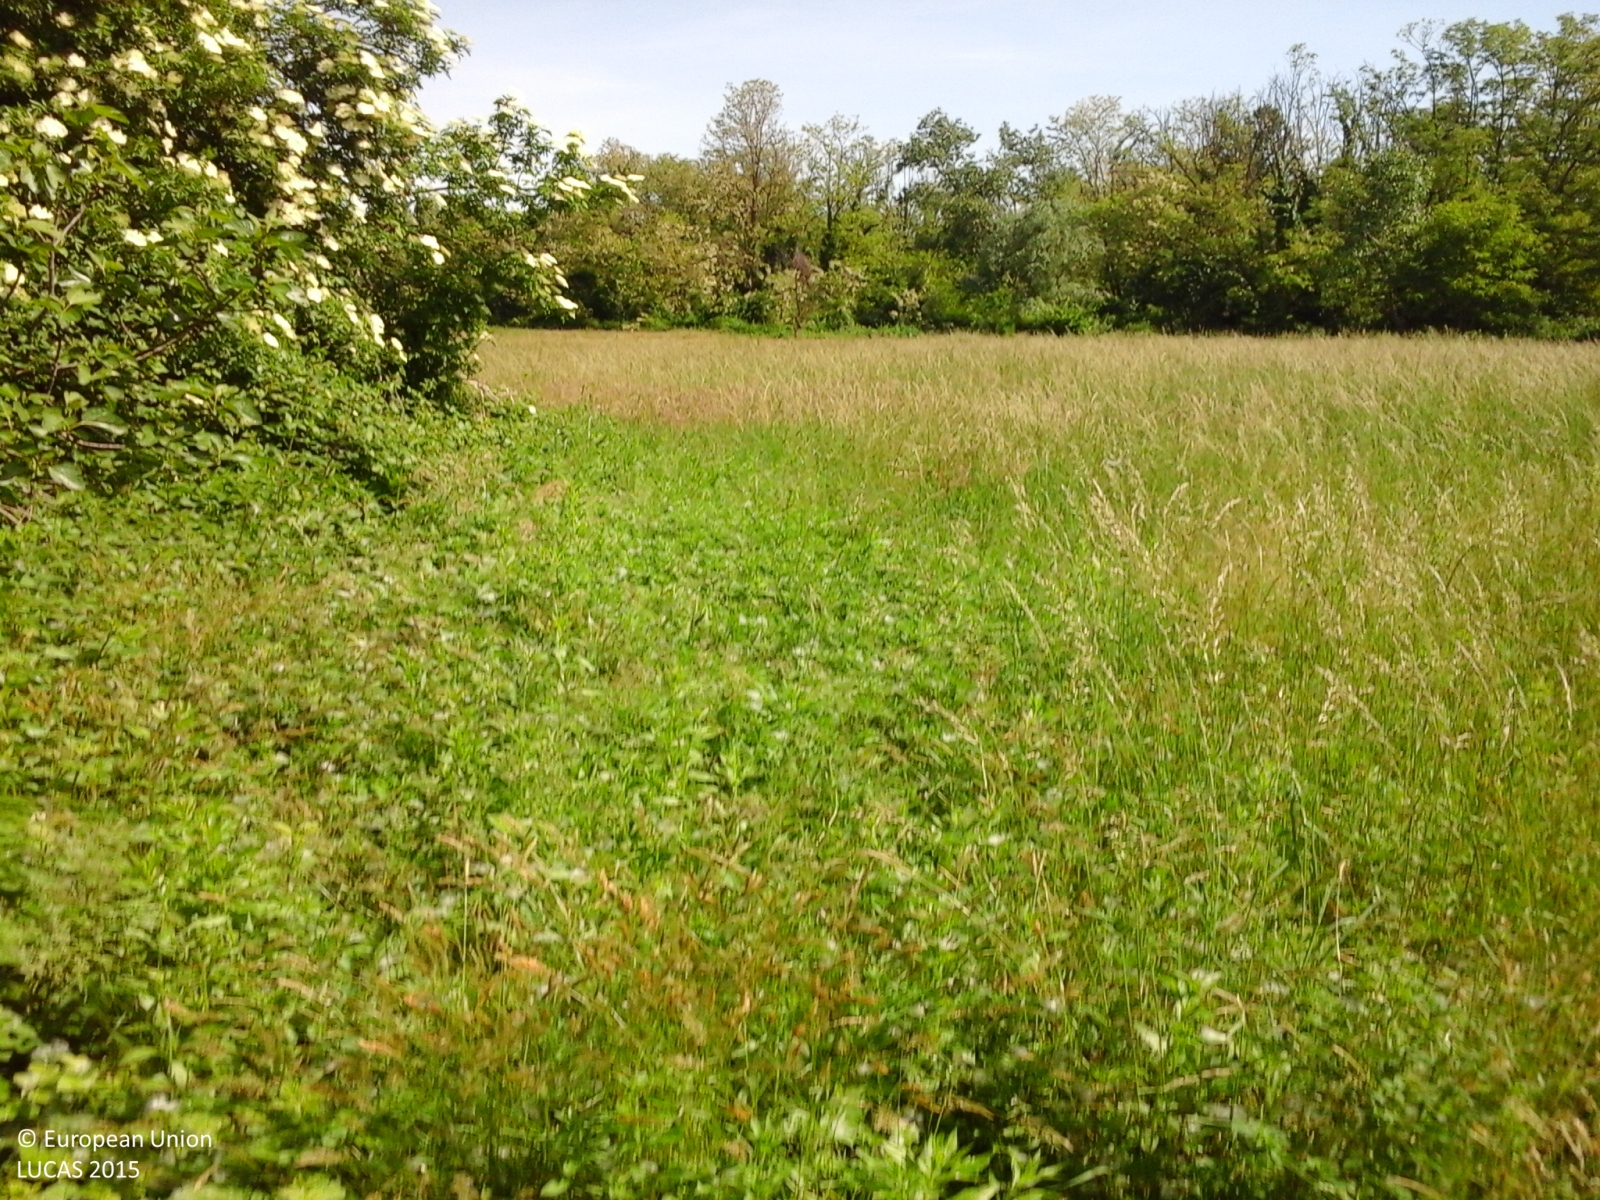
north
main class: Shrubland
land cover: Shrubland with sparse tree cover
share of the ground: > 75 %
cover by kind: shrubs 80 %, herbaceous plants 15 %, broadleaved forest trees 5 %
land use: Fallow land
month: May
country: IT
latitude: 45.5726
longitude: 9.0917
